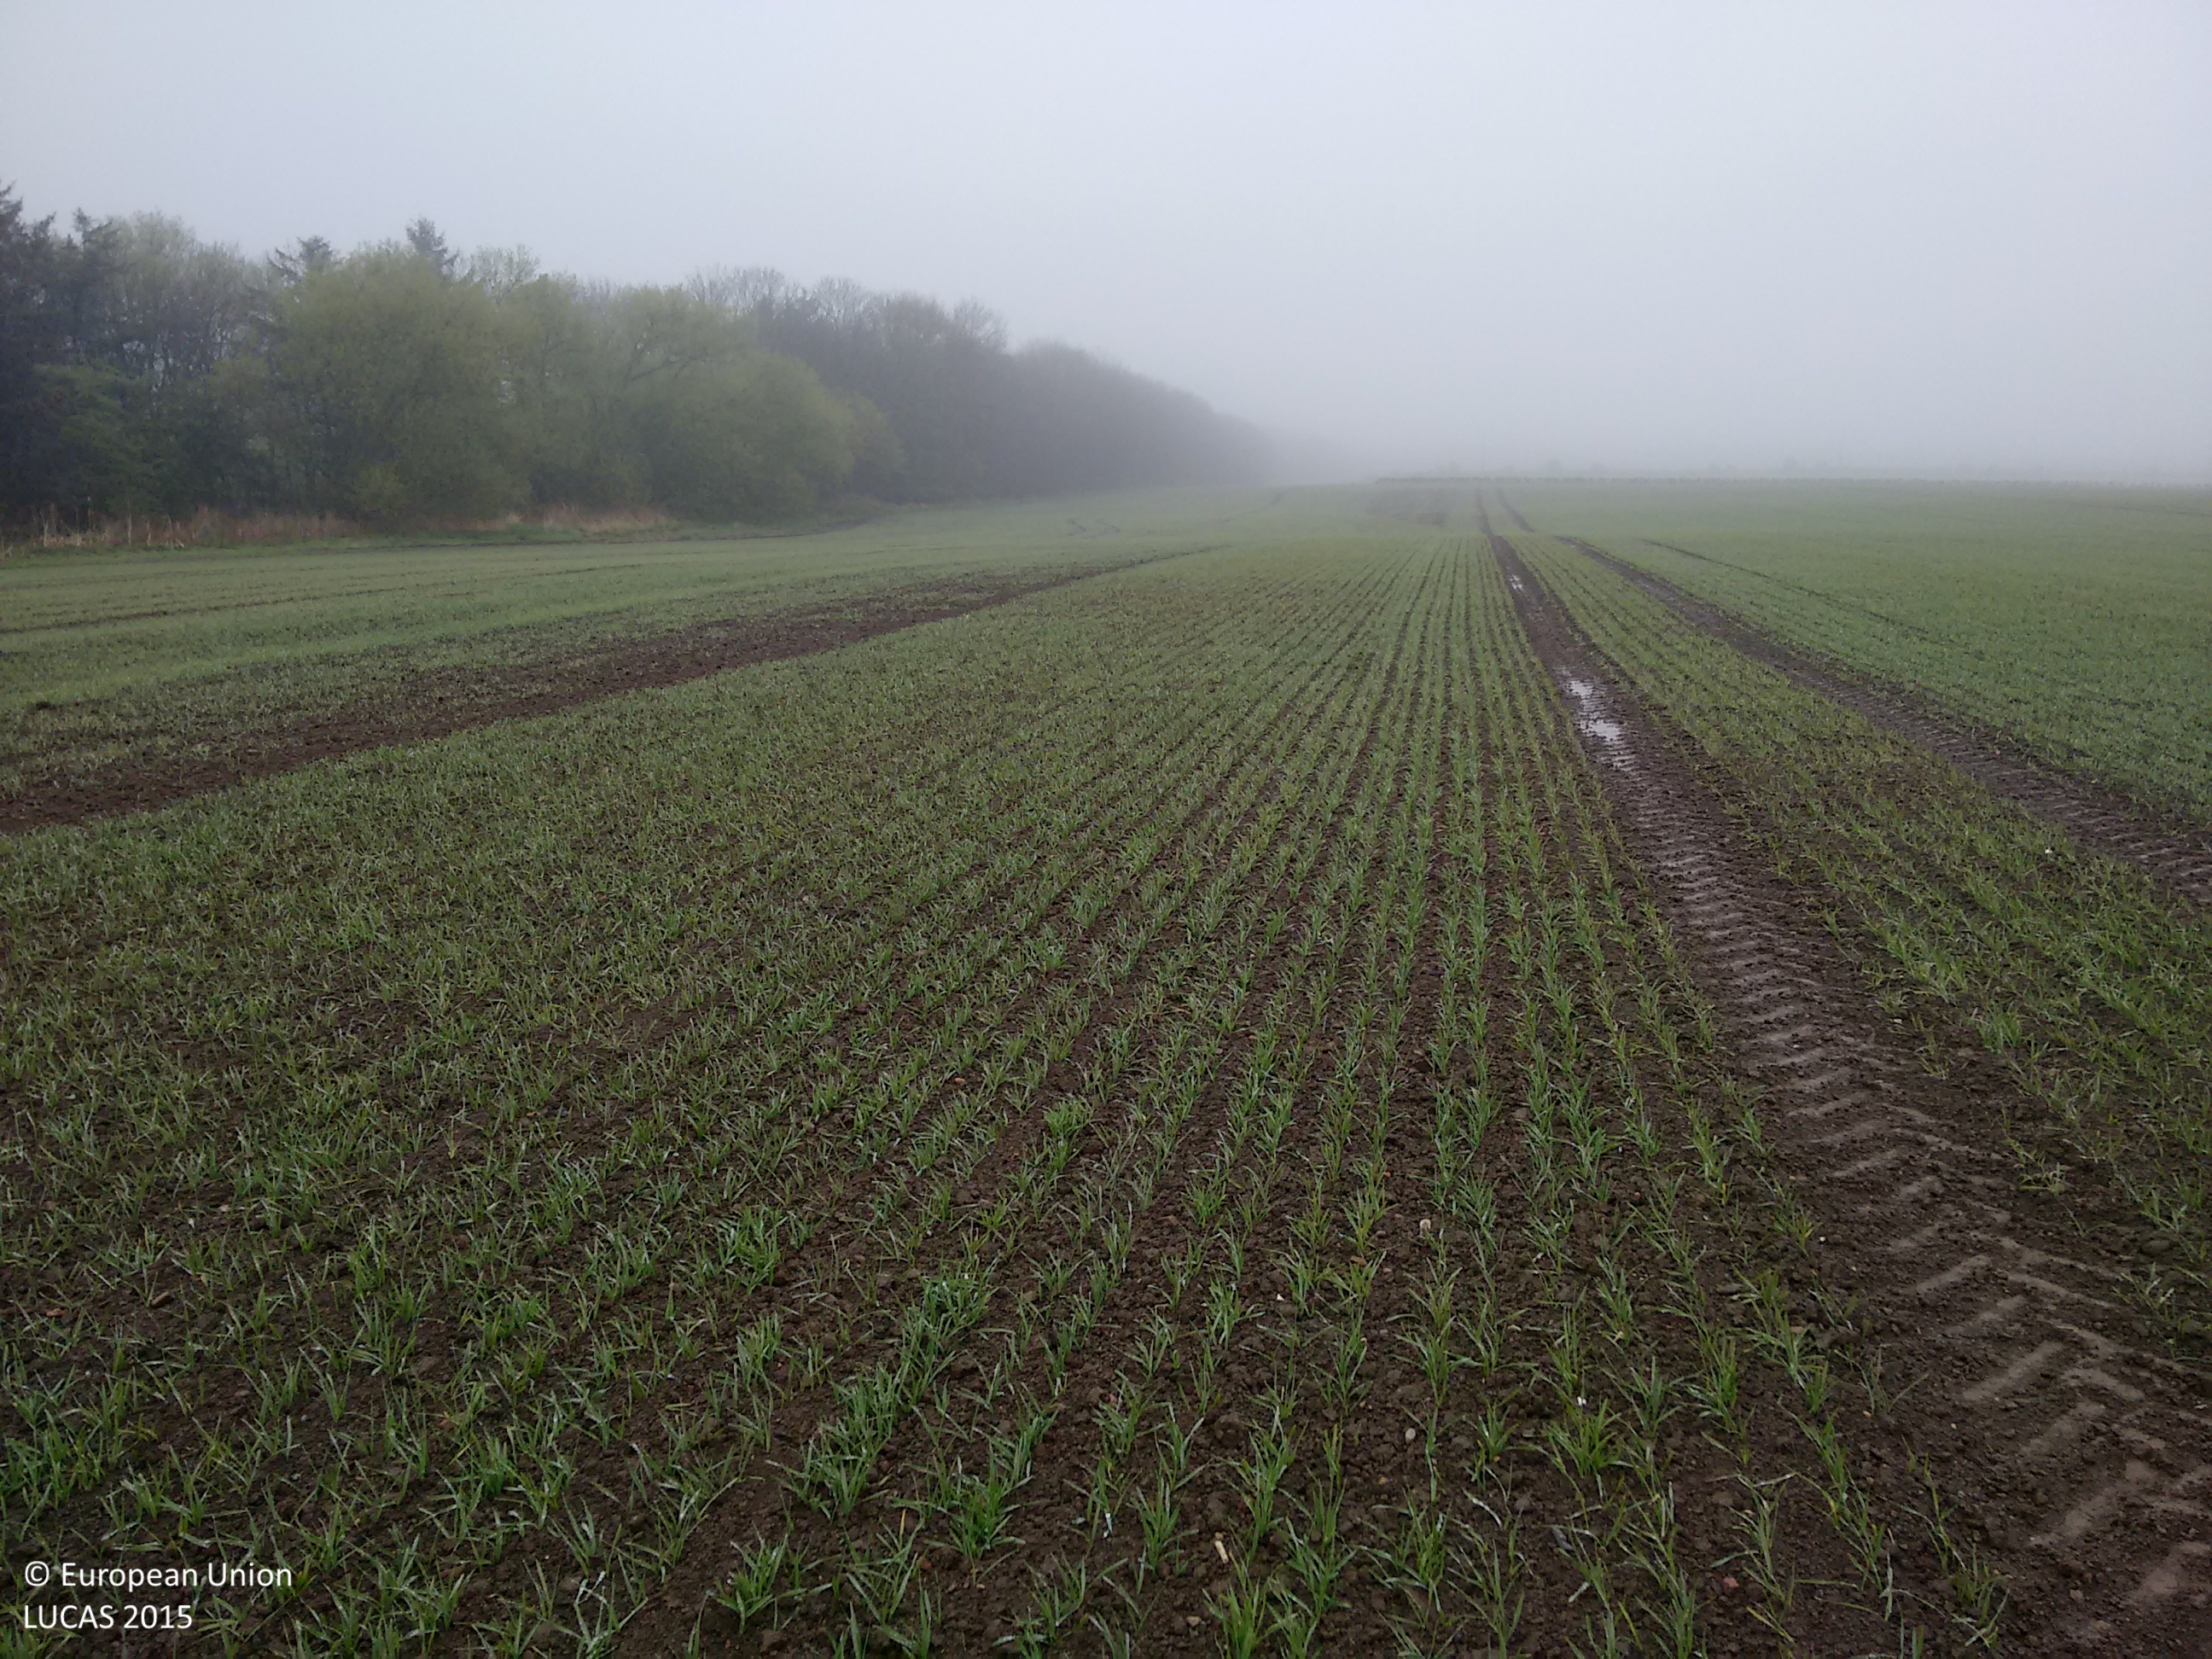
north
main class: Cropland
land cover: Common wheat
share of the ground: > 75 %
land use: Agriculture (excluding fallow land and kitchen gardens)
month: May
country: GB
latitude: 55.2082
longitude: -1.5664
